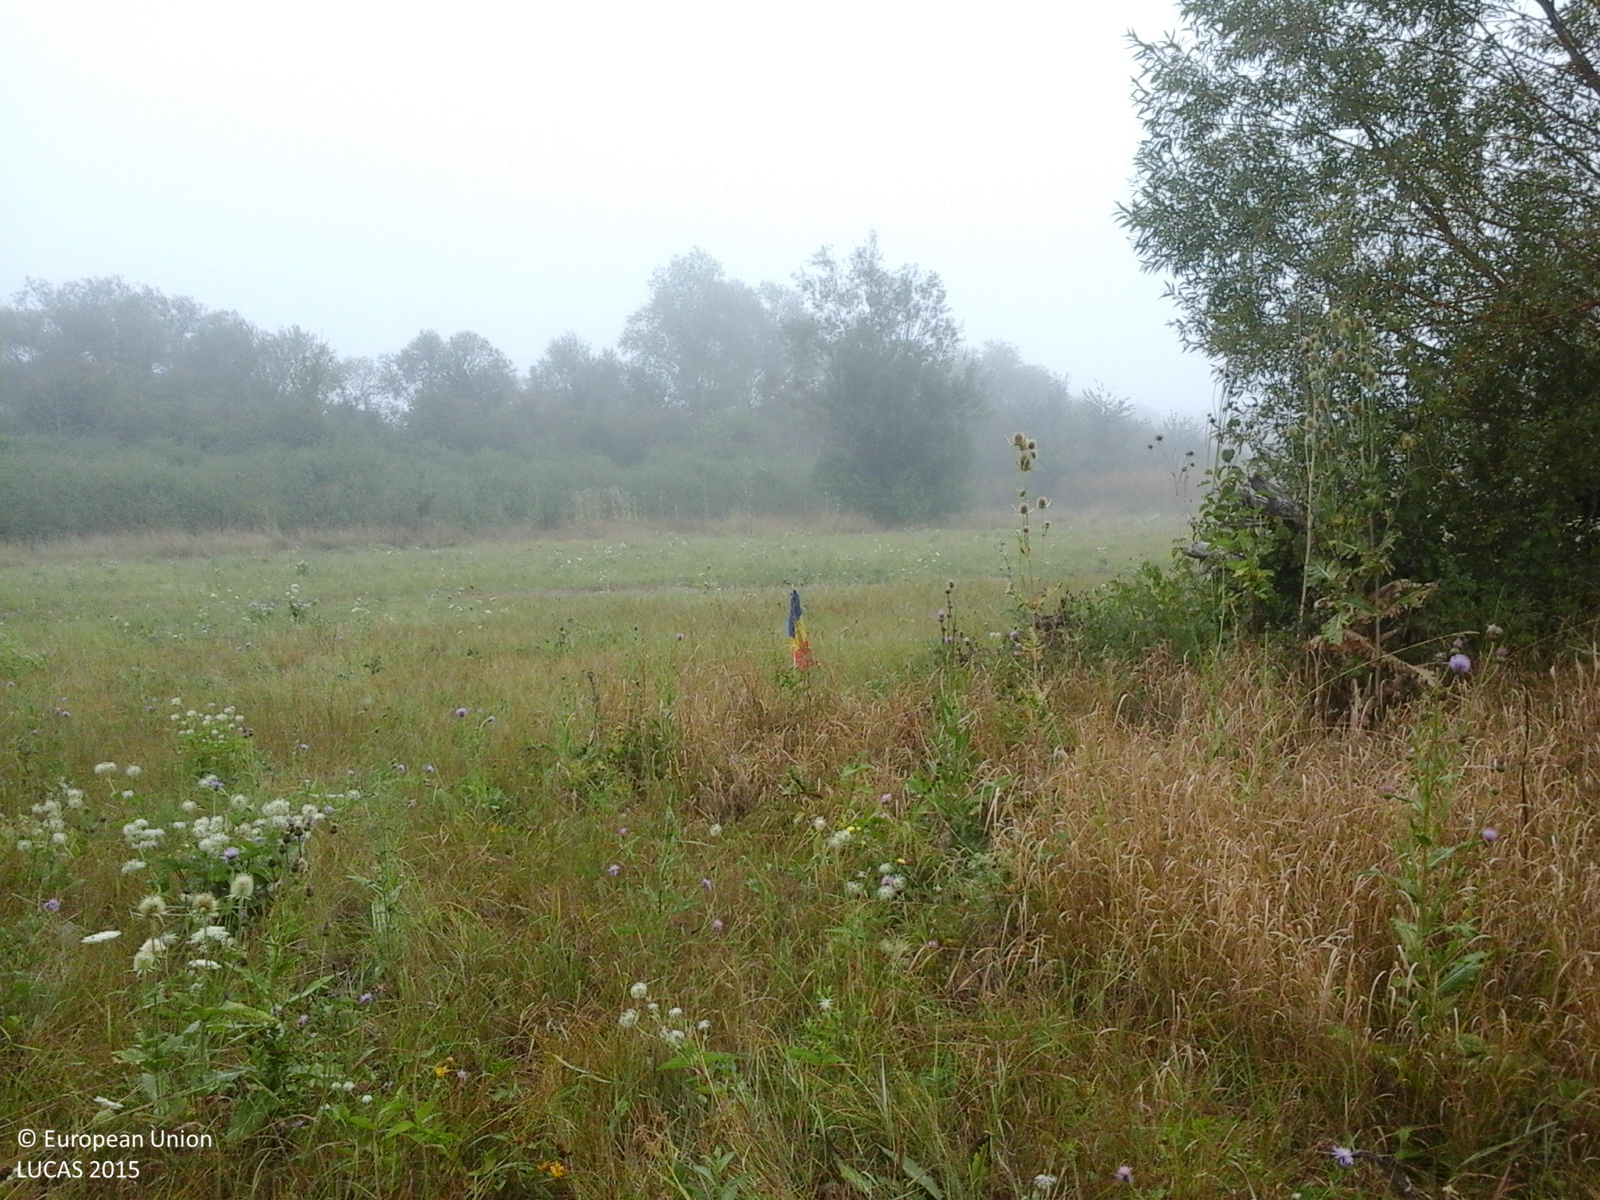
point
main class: Grassland
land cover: Grassland with sparse tree/shrub cover
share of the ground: > 75 %
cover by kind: herbaceous plants 90 %, broadleaved forest trees 5 %, shrubs 5 %
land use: Agriculture (excluding fallow land and kitchen gardens)
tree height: < 5 m
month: August
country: RO
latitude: 44.9589
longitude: 21.5527
